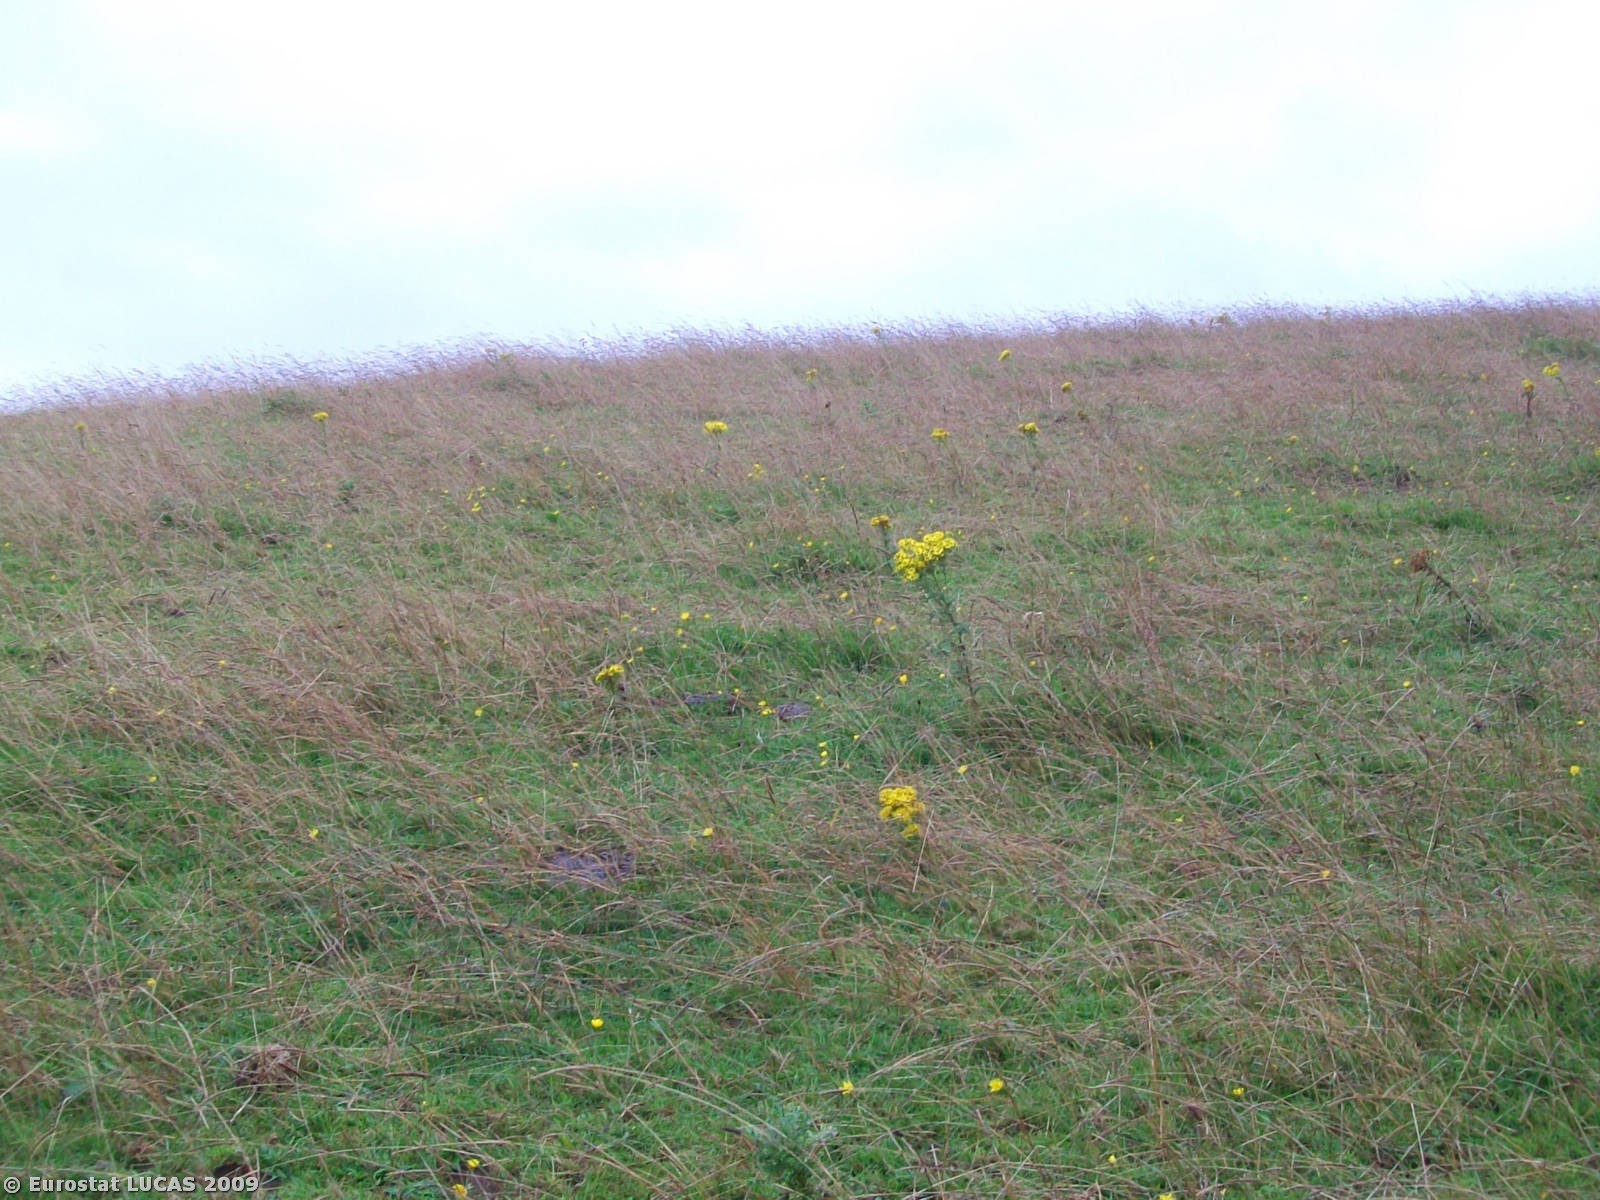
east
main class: Grassland
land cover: Grassland without tree/shrub cover
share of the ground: > 75 %
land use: Agriculture (excluding fallow land and kitchen gardens)
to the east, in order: Grassland without tree/shrub cover; Abandoned hedges; Grassland without tree/shrub cover; Fences; Dry stone walls; Abandoned hedges; Grassland without tree/shrub cover
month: August
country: GB
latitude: 54.3590
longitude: -5.6272
